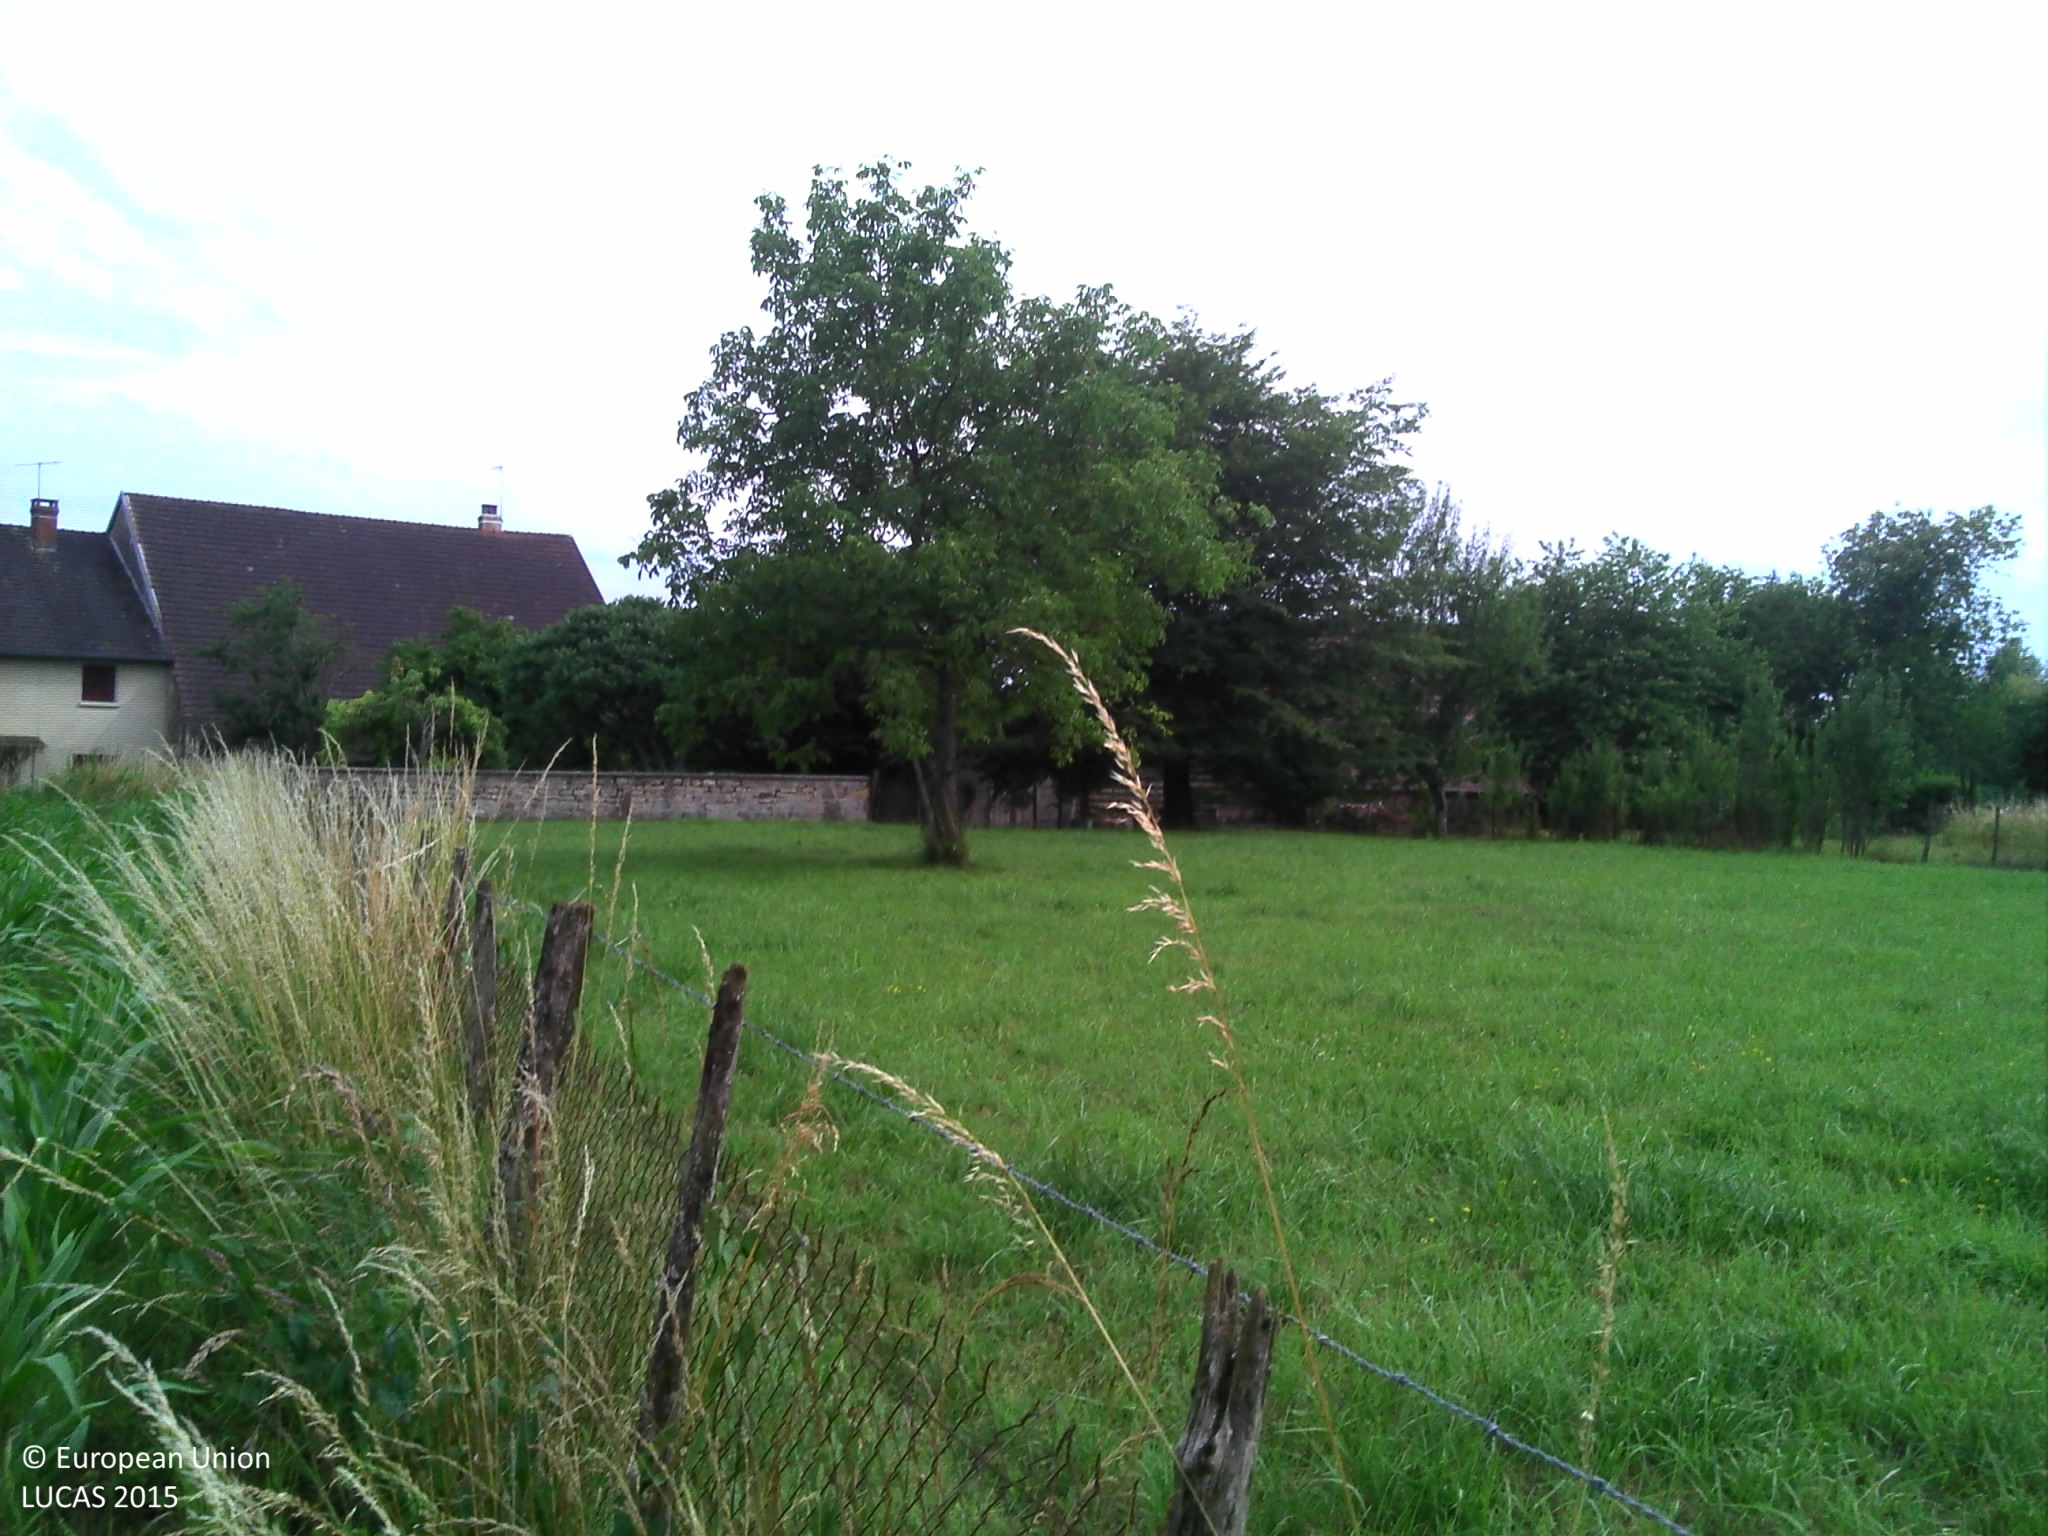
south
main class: Grassland
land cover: Grassland without tree/shrub cover
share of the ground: > 75 %
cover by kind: herbaceous plants 100 %
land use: Agriculture (excluding fallow land and kitchen gardens)
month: June
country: FR
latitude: 46.7430
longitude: 5.4866
